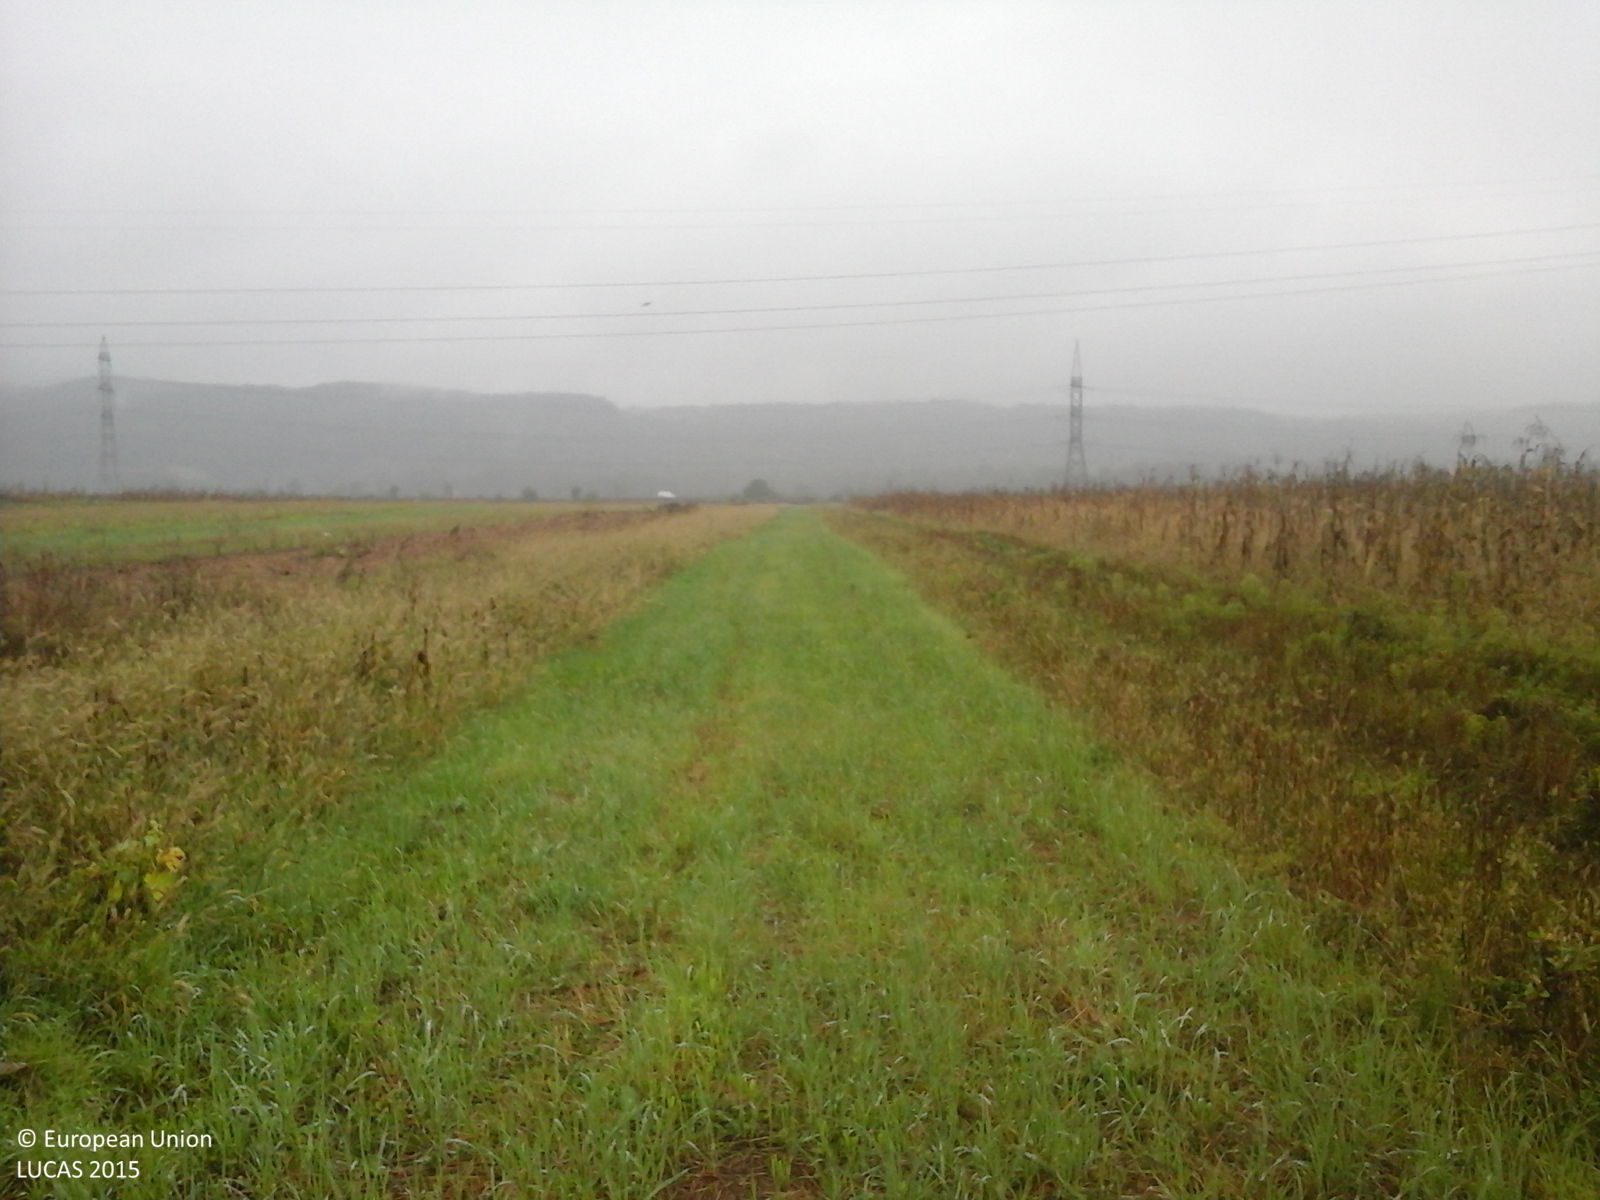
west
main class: Grassland
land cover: Grassland without tree/shrub cover
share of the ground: > 75 %
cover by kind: herbaceous plants 100 %
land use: Agriculture (excluding fallow land and kitchen gardens)
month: September
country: RO
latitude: 44.9217
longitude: 23.5238
